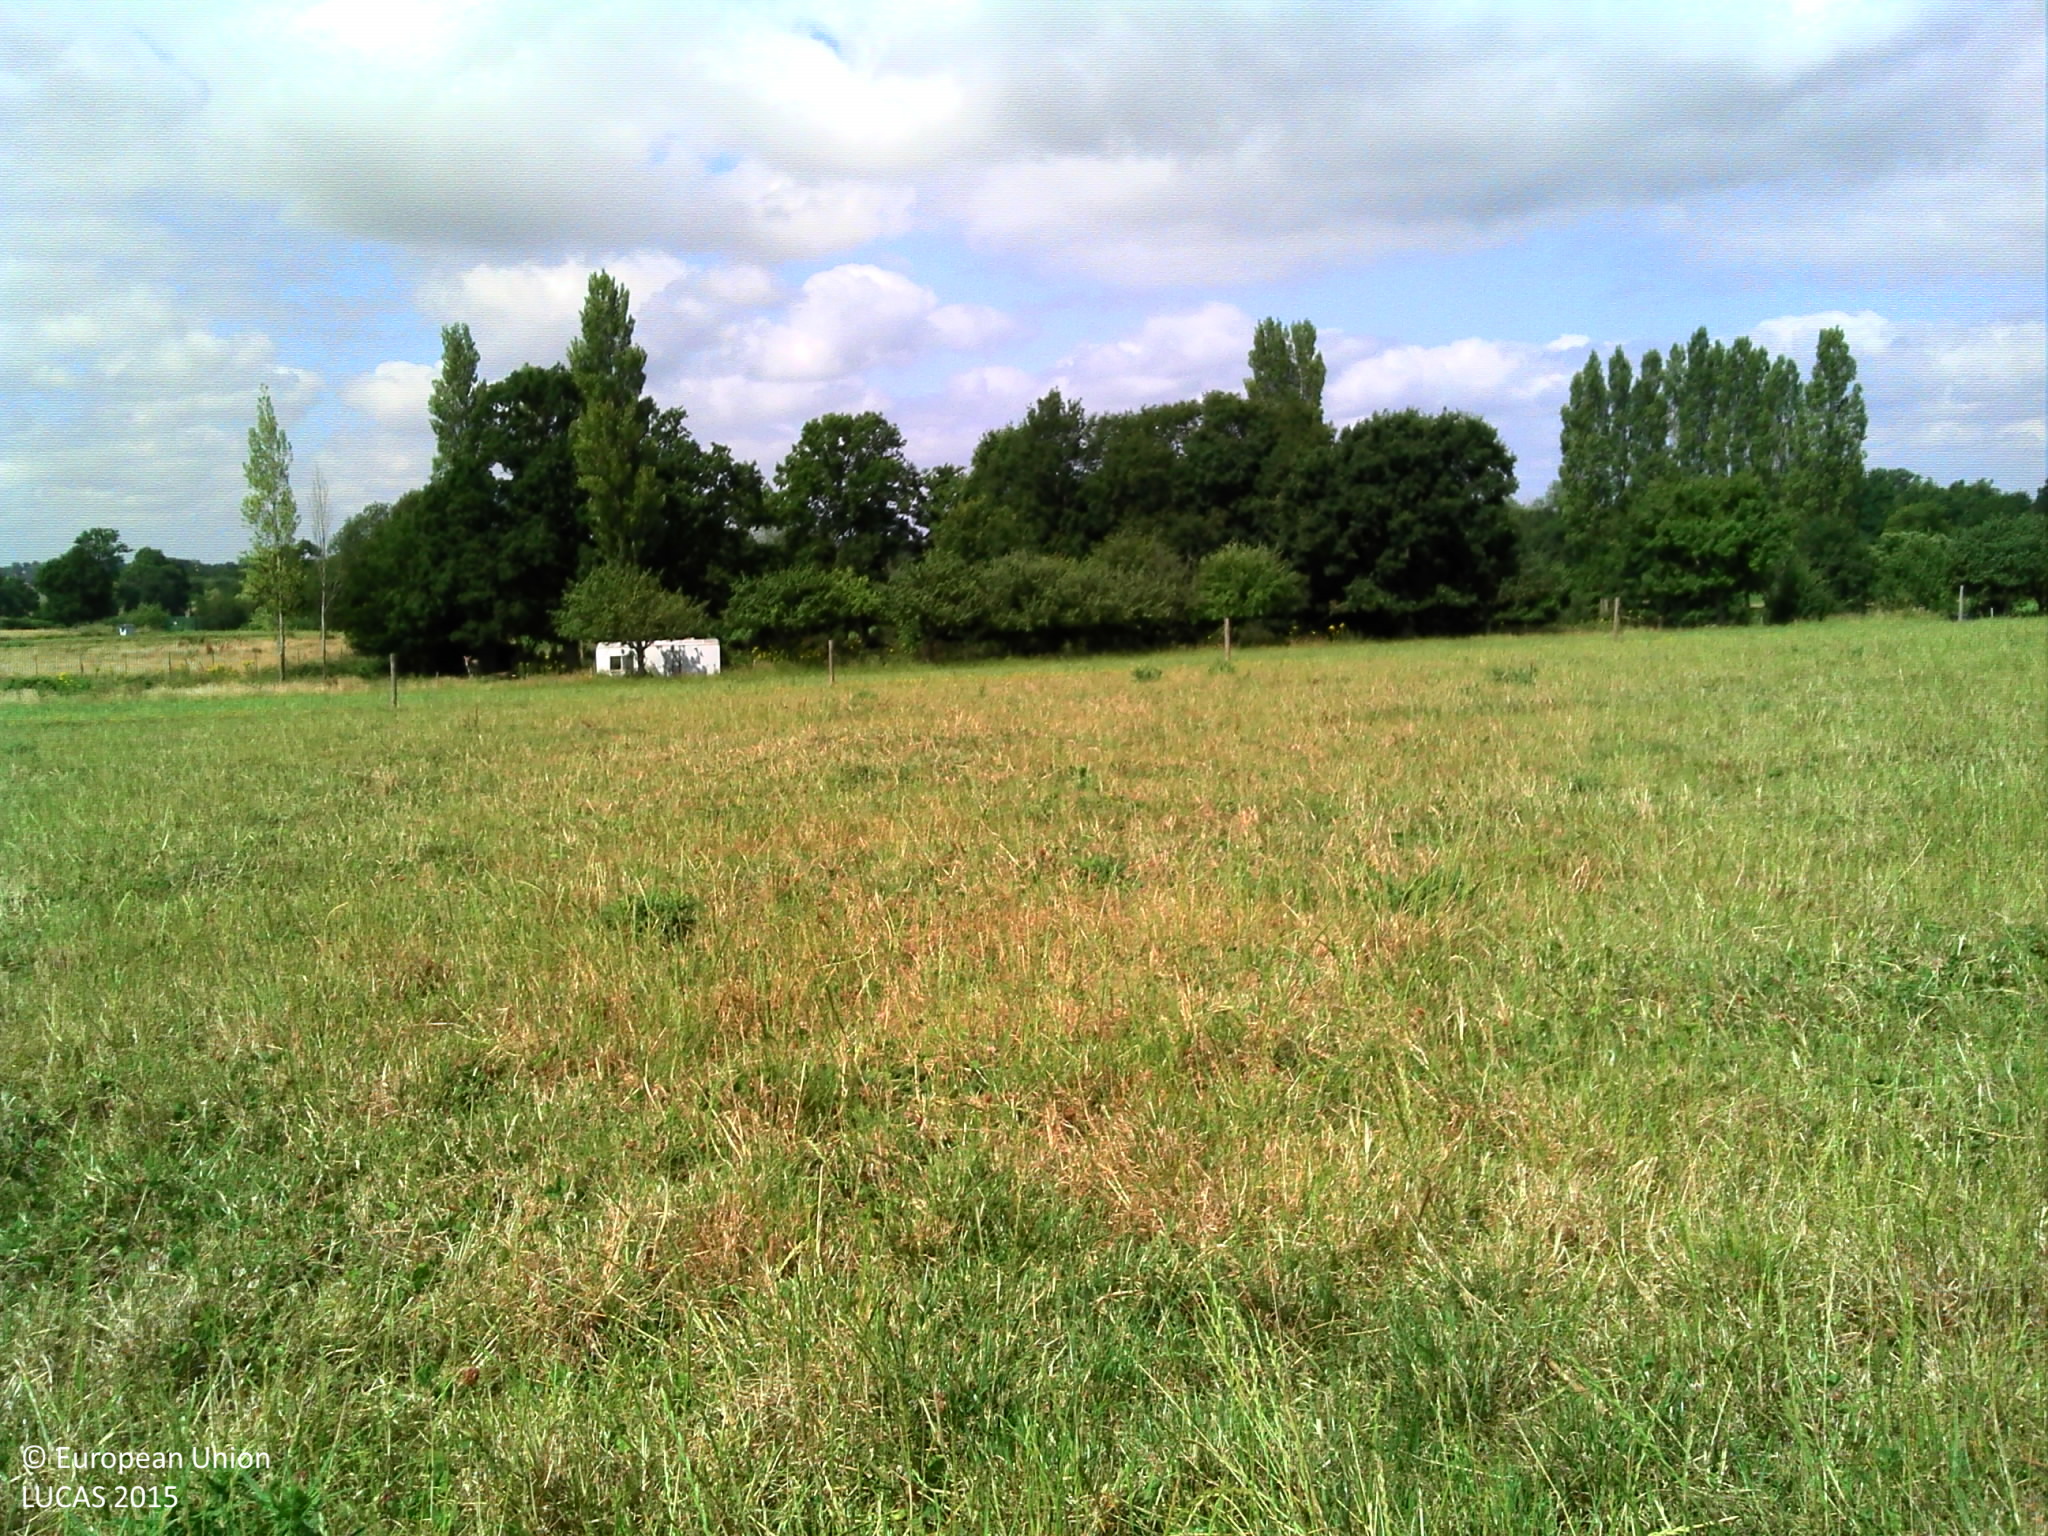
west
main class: Grassland
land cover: Grassland without tree/shrub cover
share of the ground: > 75 %
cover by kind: herbaceous plants 95 %, unconsolidated bare surface 5 %
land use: Agriculture (excluding fallow land and kitchen gardens)
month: July
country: FR
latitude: 48.4691
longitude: -2.2166
